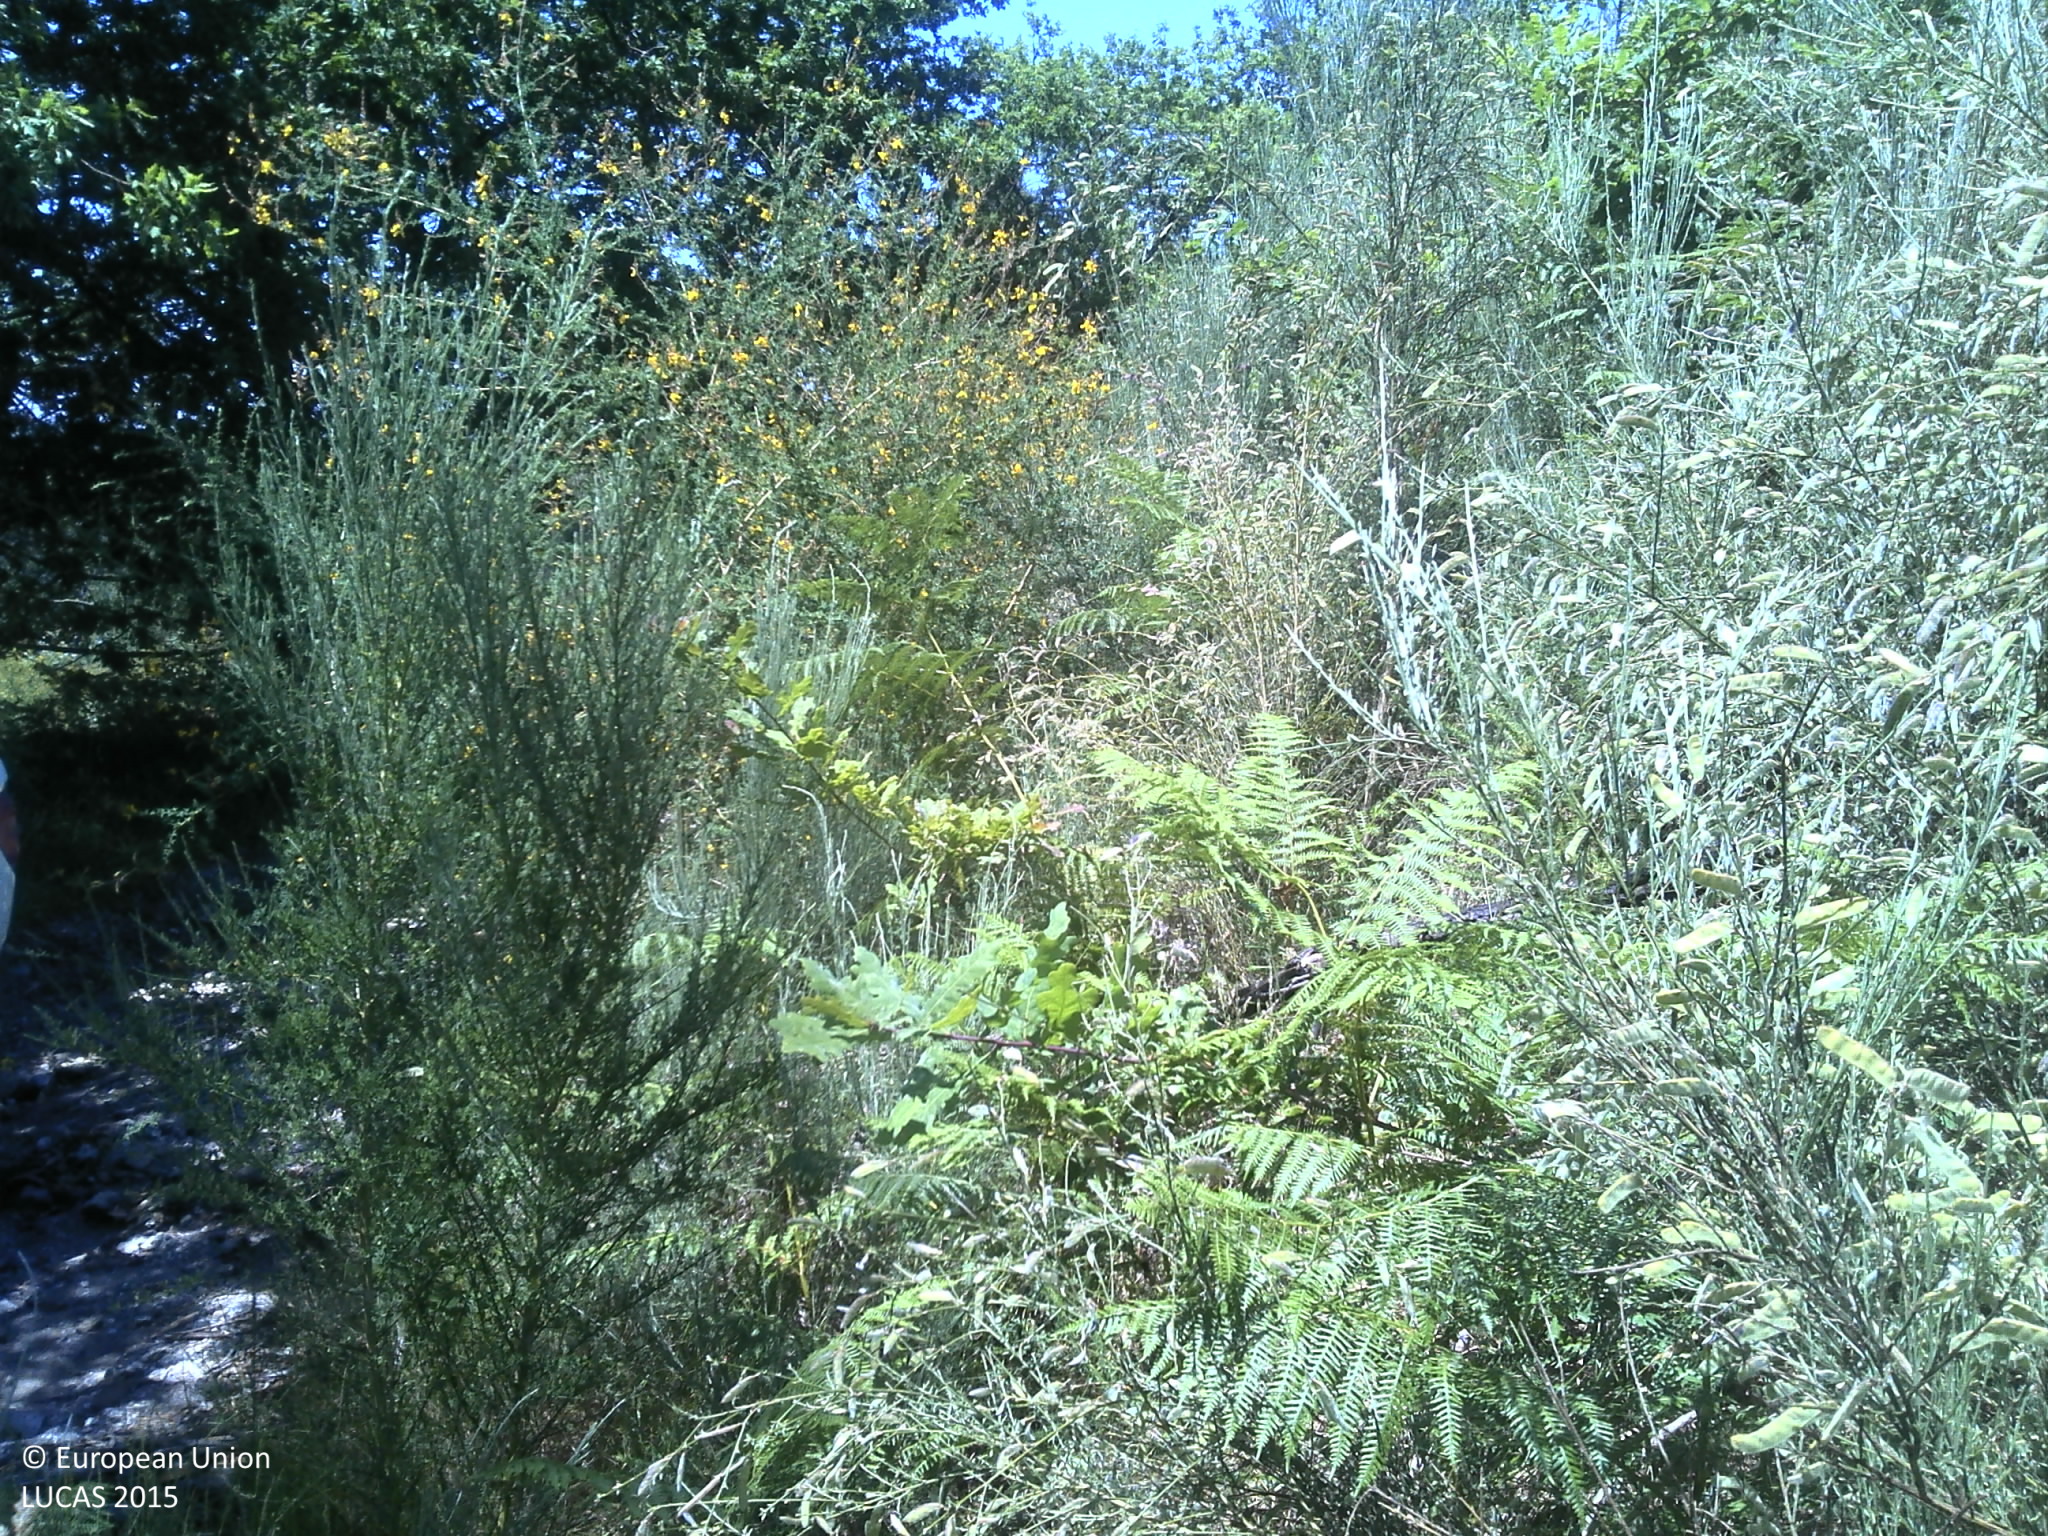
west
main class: Shrubland
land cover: Shrubland without tree cover
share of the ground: > 75 %
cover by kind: shrubs 85 %, unconsolidated bare surface 10 %, herbaceous plants 5 %
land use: Semi-natural and natural areas not in use
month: June
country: PT
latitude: 41.4003
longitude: -8.0709
